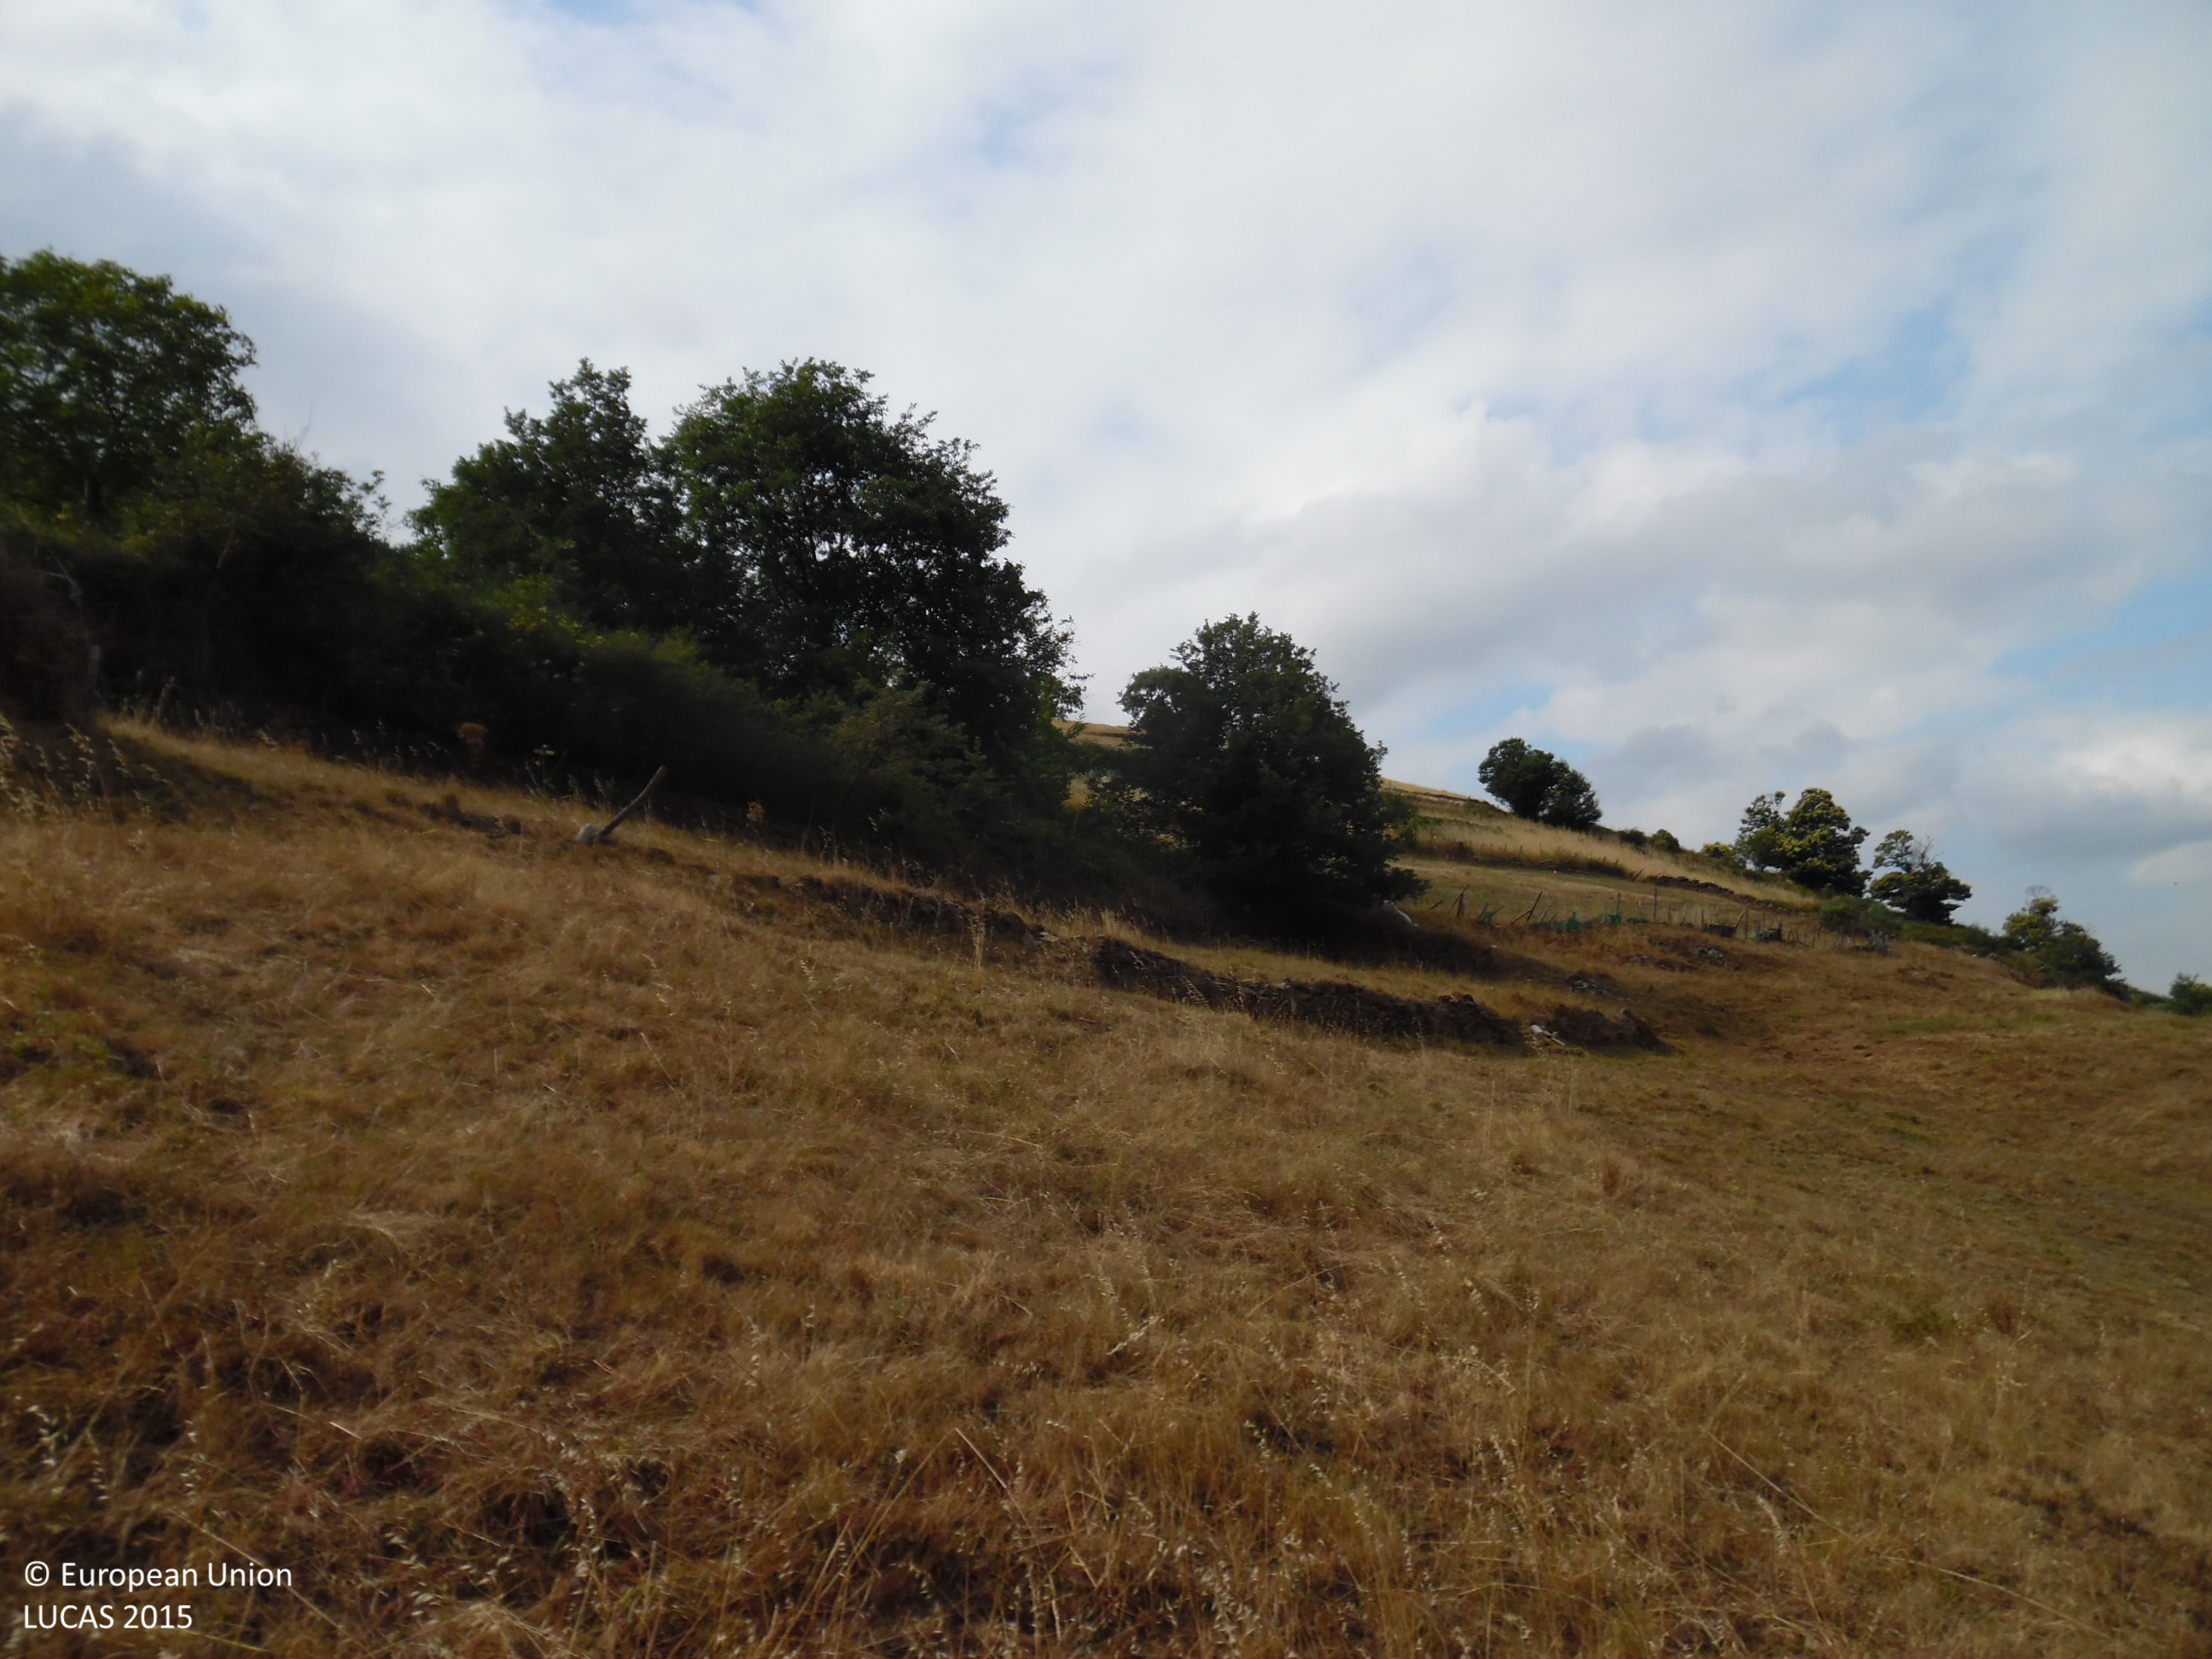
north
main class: Grassland
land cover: Grassland without tree/shrub cover
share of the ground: > 75 %
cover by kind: herbaceous plants 95 %, shrubs 5 %
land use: Agriculture (excluding fallow land and kitchen gardens)
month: July
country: ES
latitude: 43.1544
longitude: -6.5686
